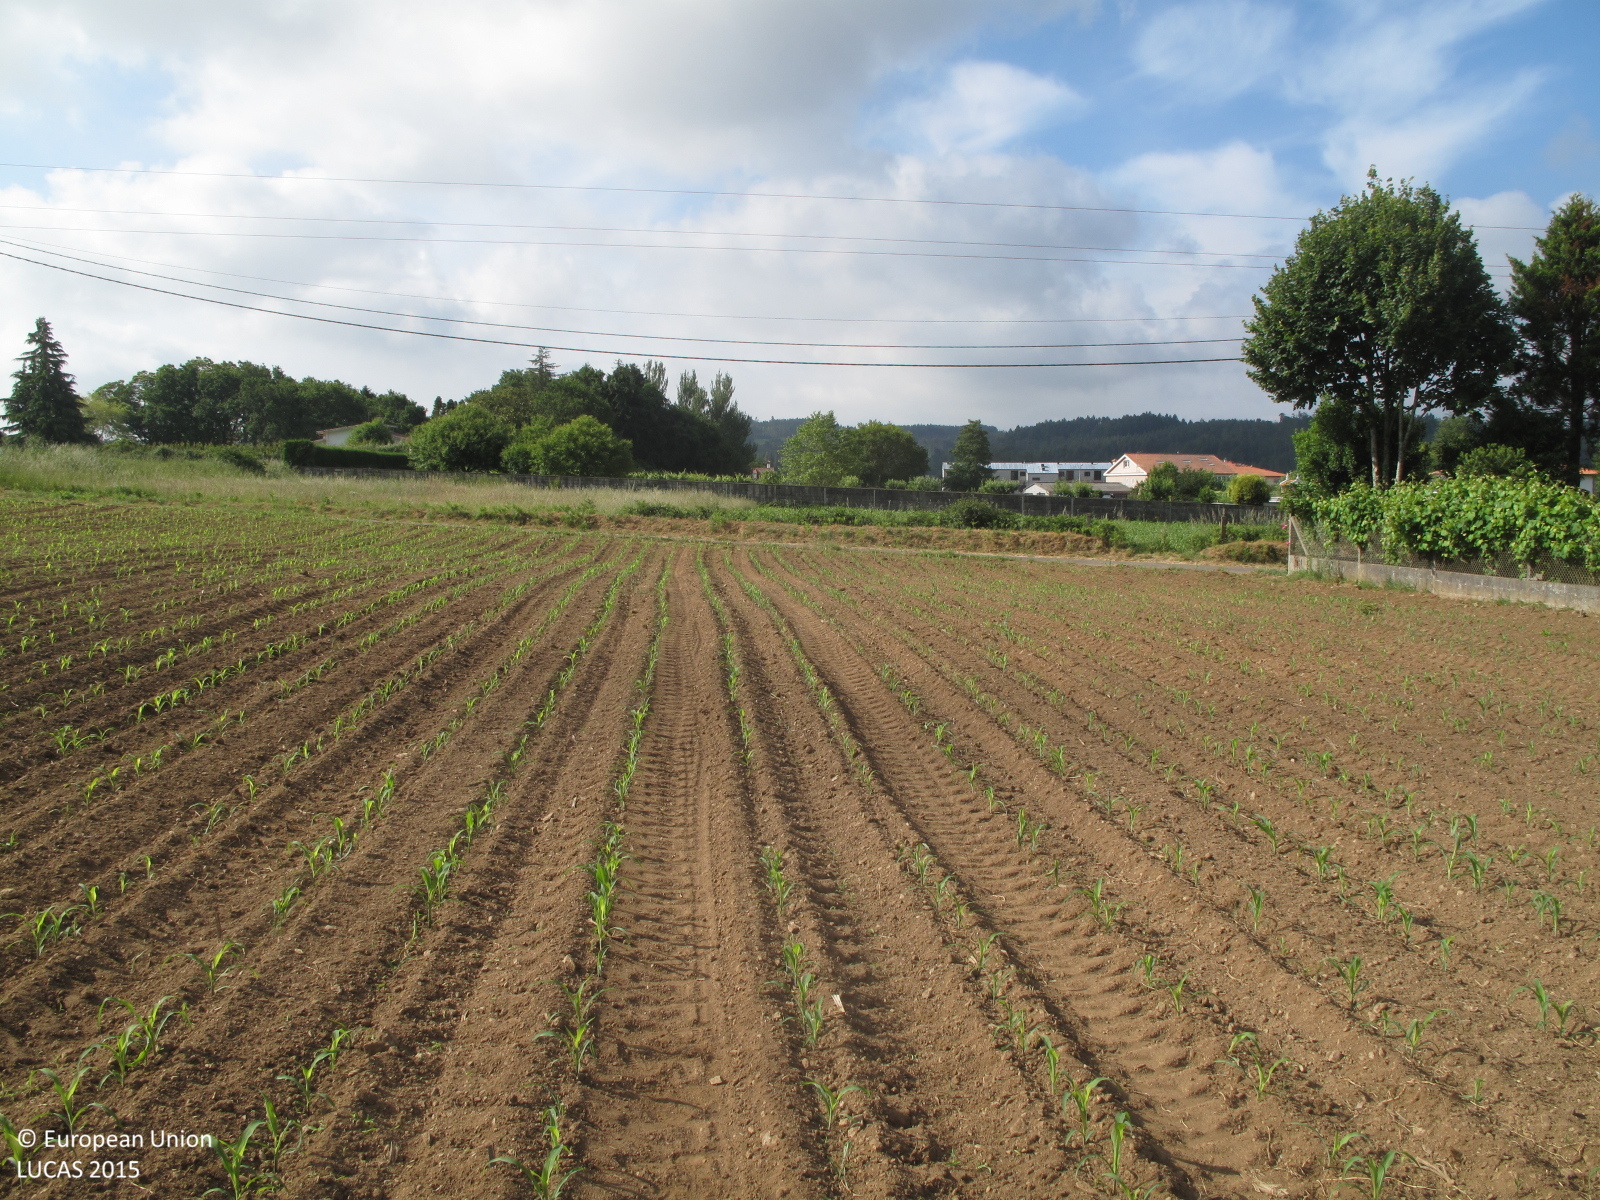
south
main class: Cropland
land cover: Maize
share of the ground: < 10 %
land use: Agriculture (excluding fallow land and kitchen gardens)
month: June
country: ES
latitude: 42.9025
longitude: -8.4361
